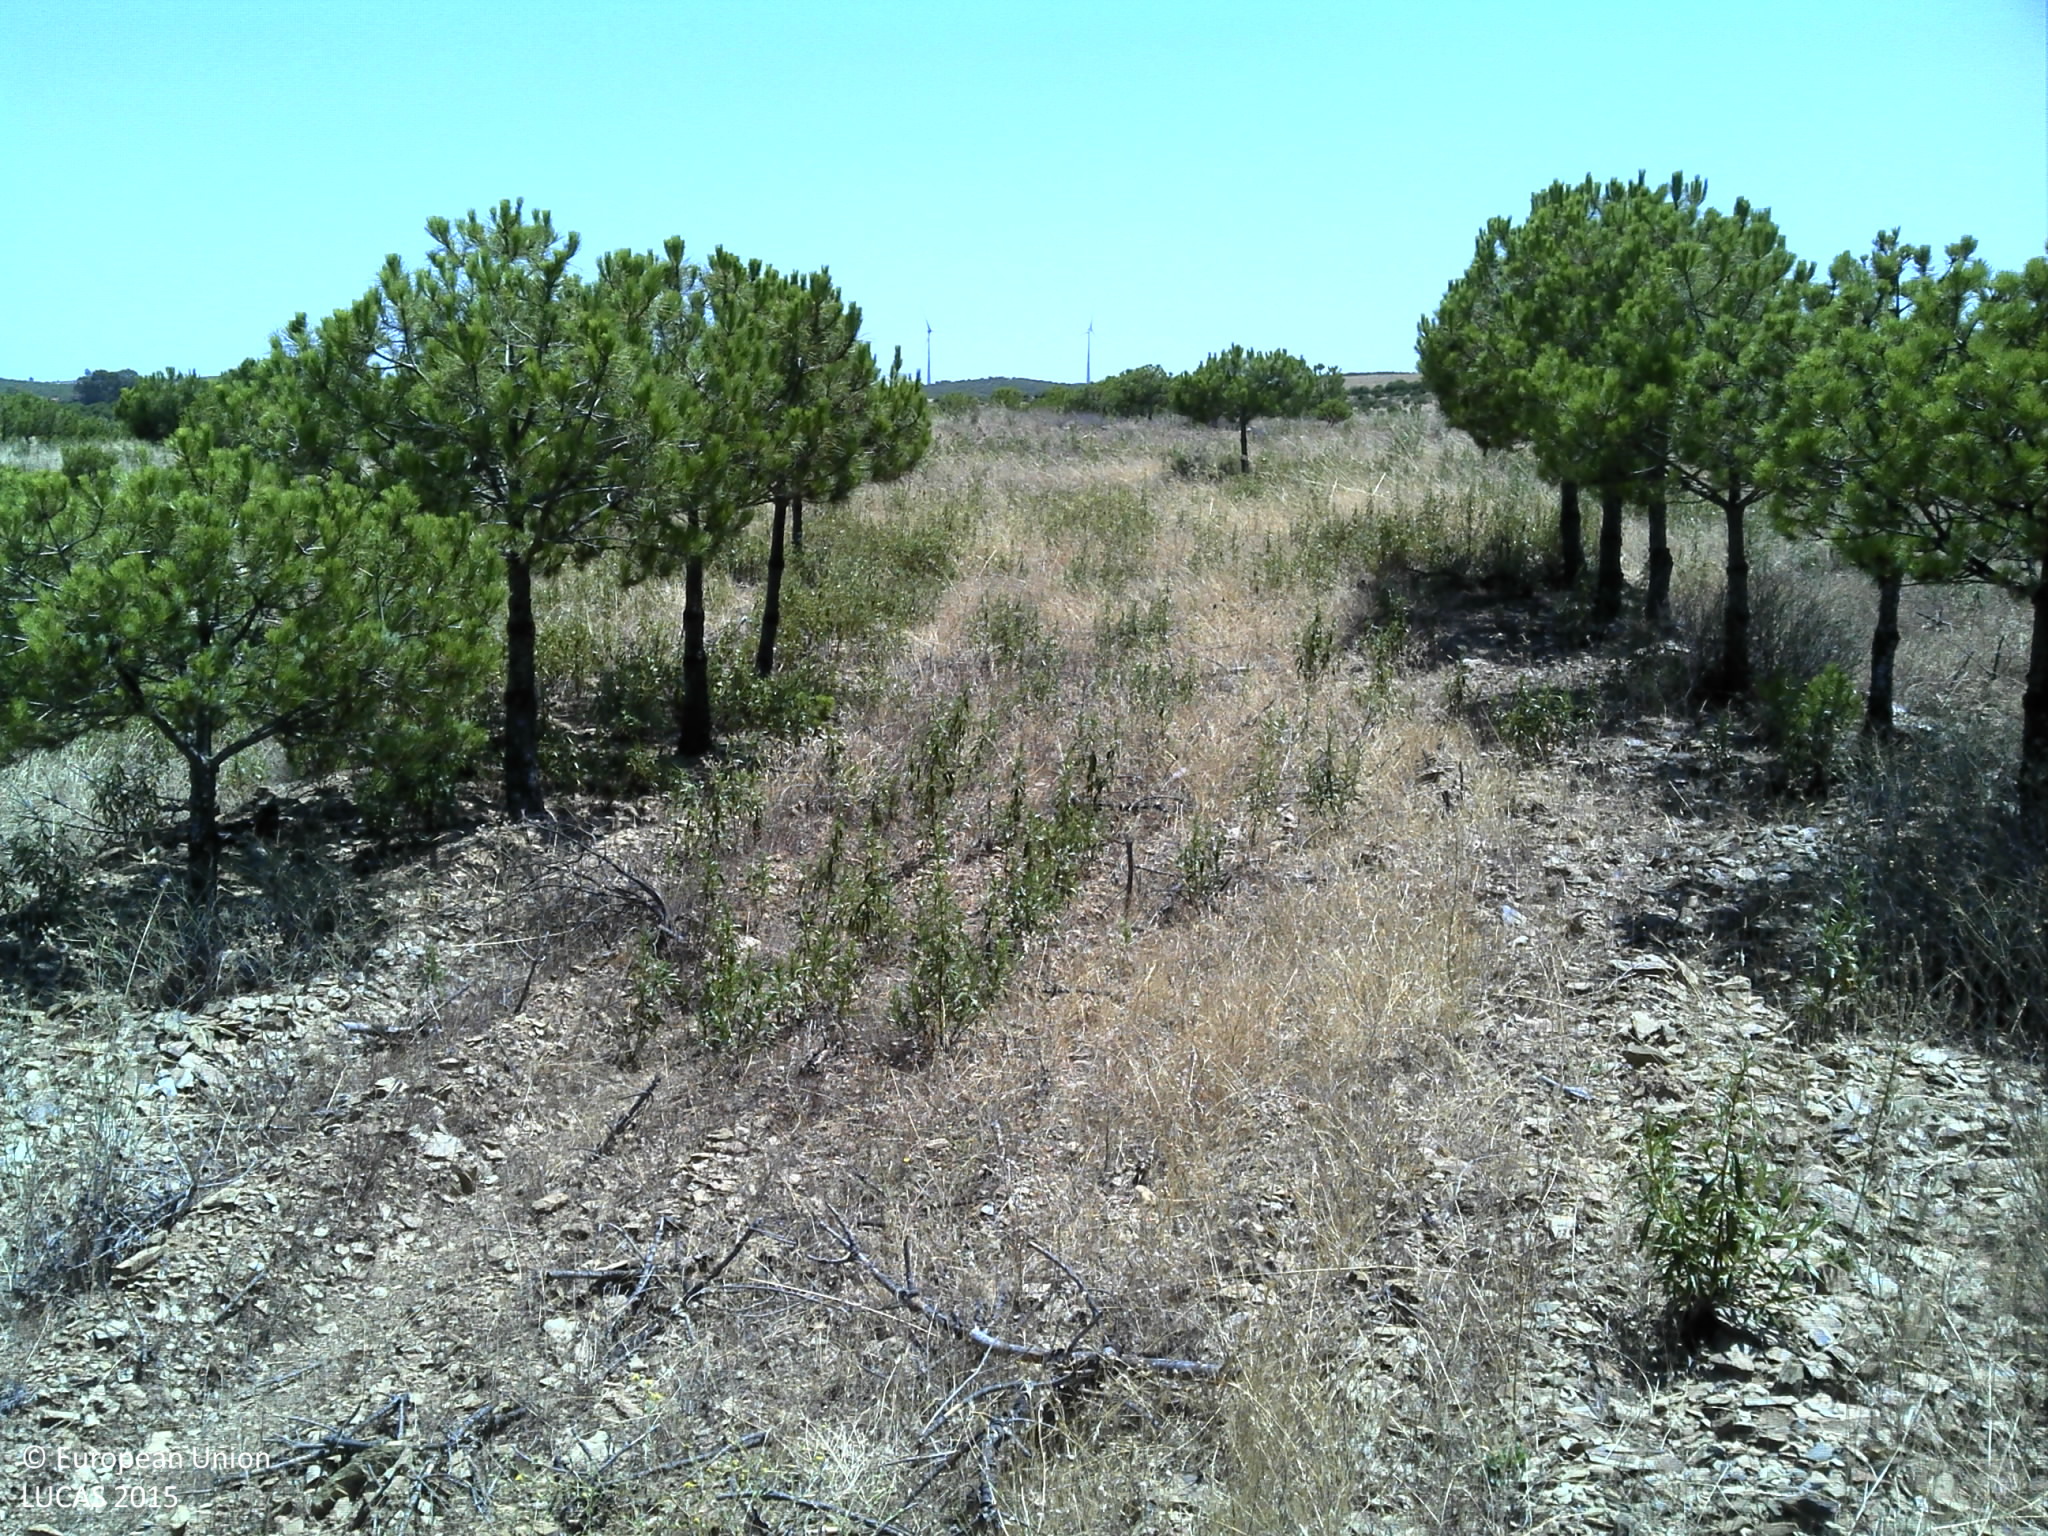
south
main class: Woodland
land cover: Pine dominated coniferous woodland
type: coniferous forest of the mediterranean region
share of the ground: 25 - 50 %
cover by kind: coniferous forest trees 50 %, unconsolidated bare surface 30 %, shrubs 10 %, herbaceous plants 10 %
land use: Forestry
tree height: < 5 m
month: July
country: PT
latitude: 37.5131
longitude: -7.8125
